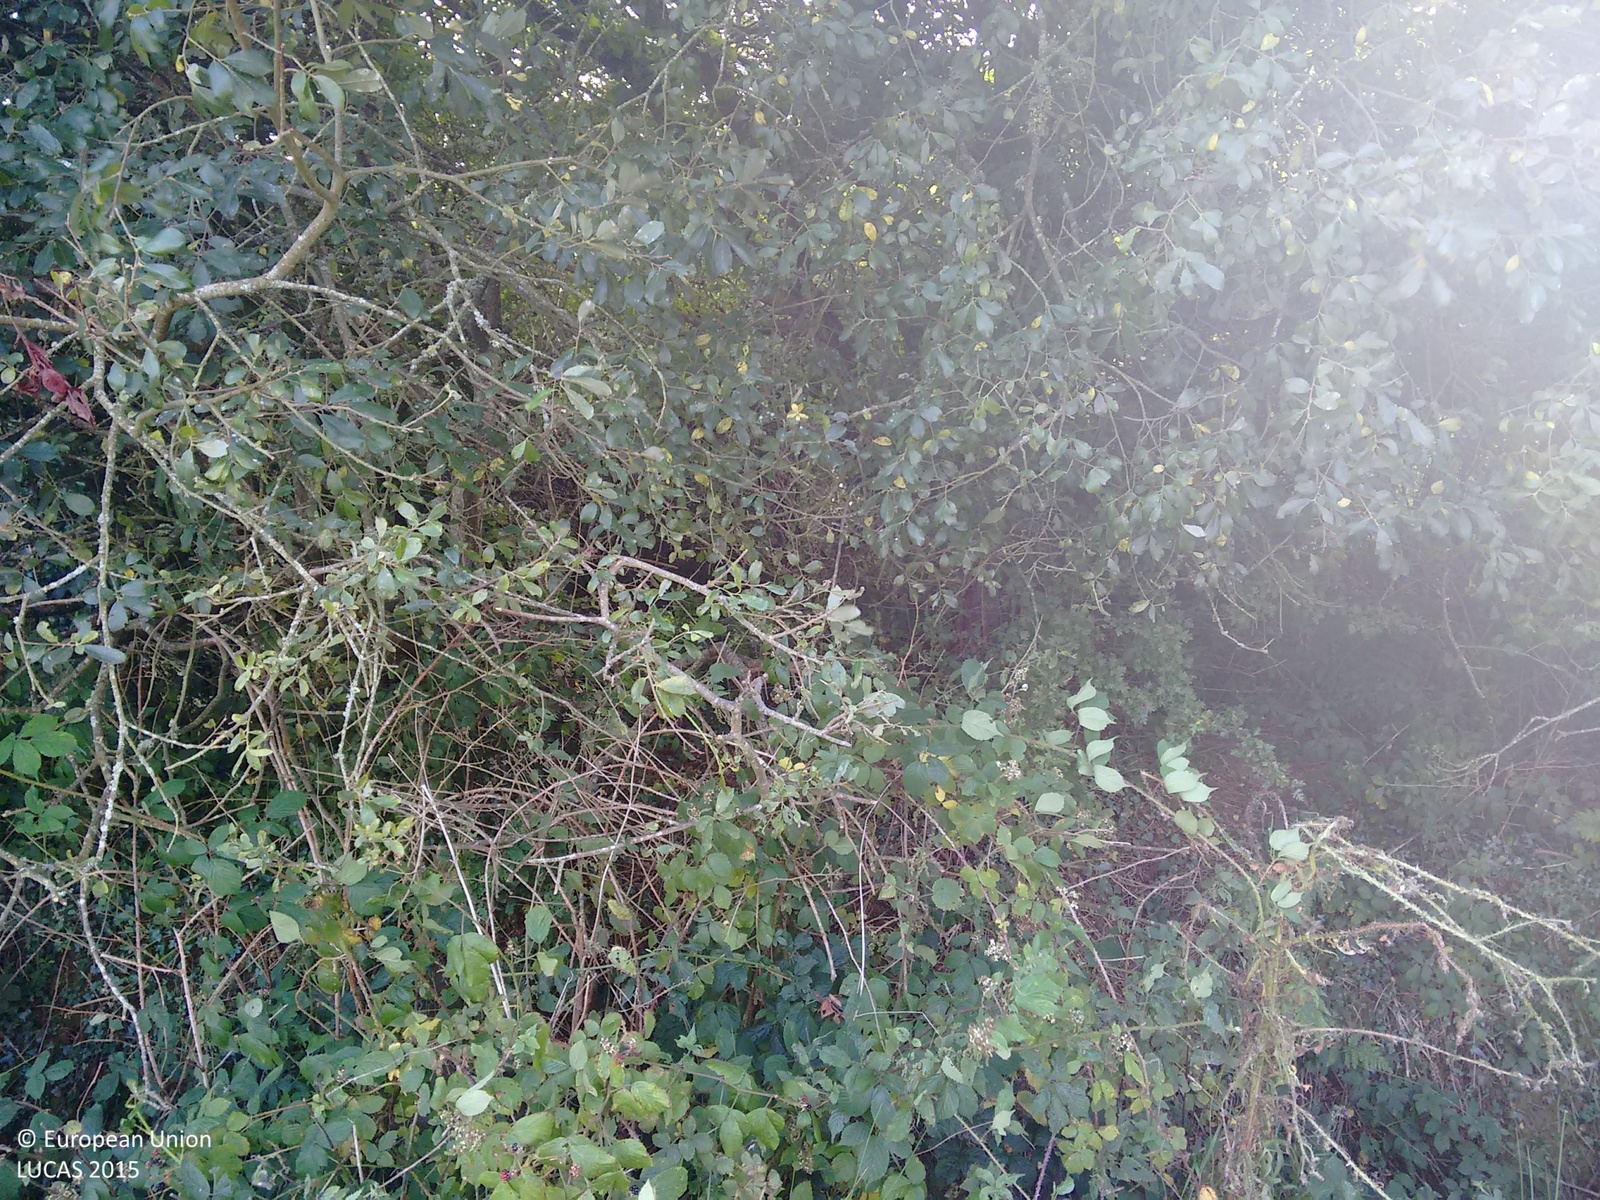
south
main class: Grassland
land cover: Grassland without tree/shrub cover
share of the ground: > 75 %
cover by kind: herbaceous plants 100 %
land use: Agriculture (excluding fallow land and kitchen gardens)
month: September
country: GB
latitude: 52.1391
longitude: -4.4975
